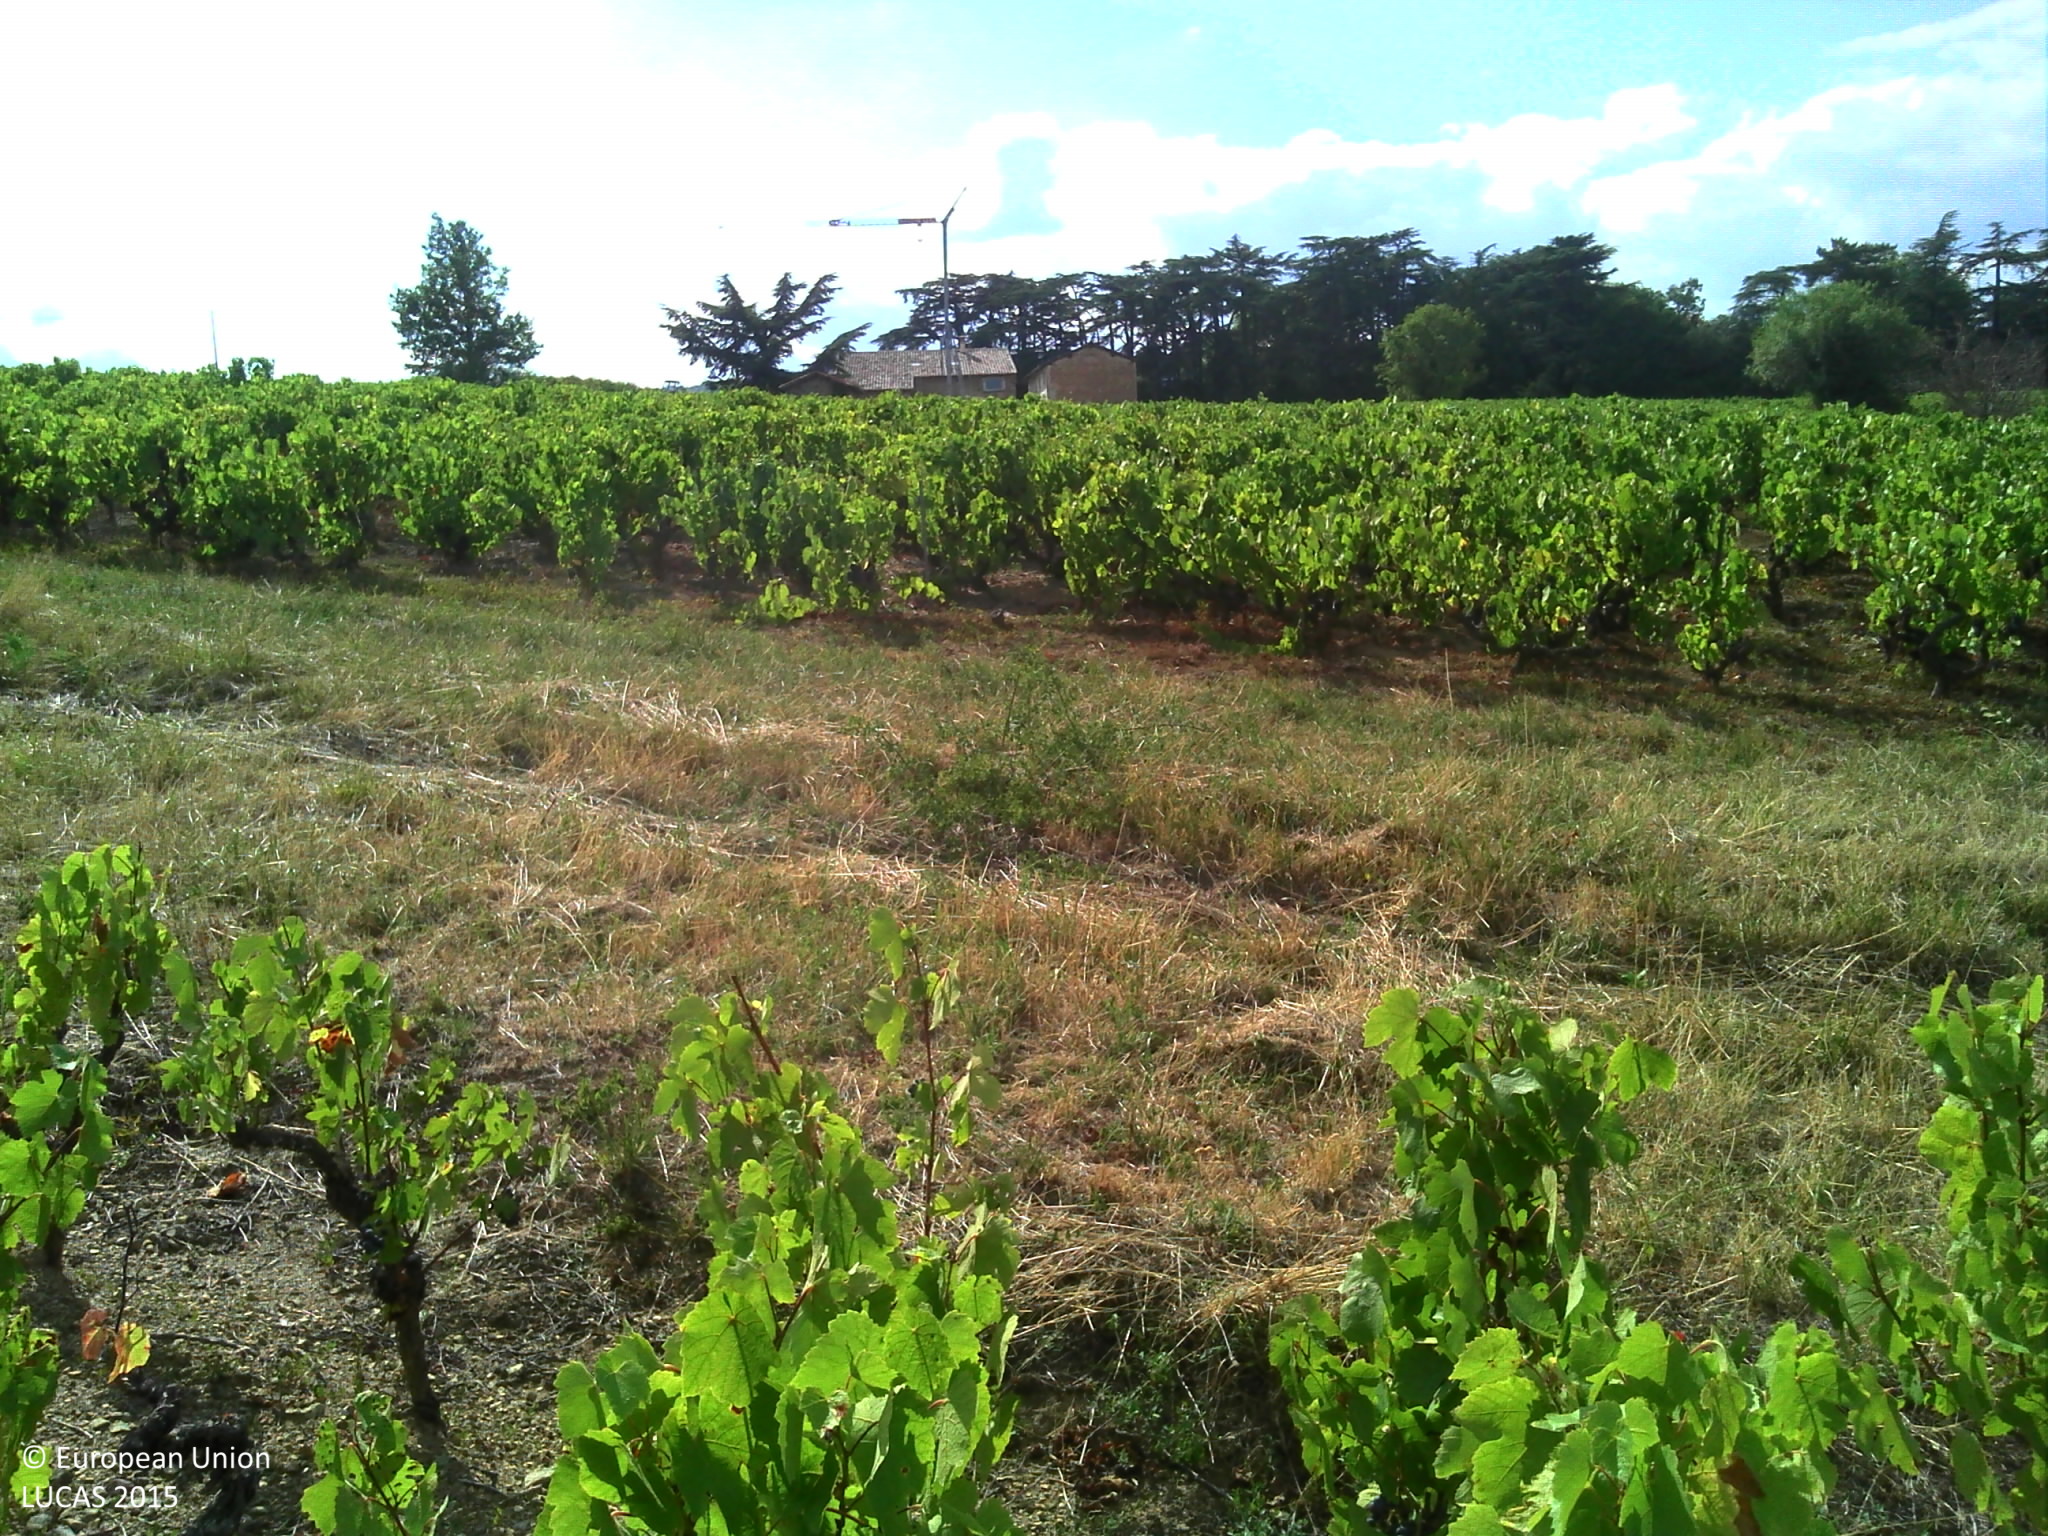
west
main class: Cropland
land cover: Vineyards
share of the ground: 50 - 75 %
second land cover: Other bare soil
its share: > 75 %
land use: Agriculture (excluding fallow land and kitchen gardens)
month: August
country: FR
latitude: 46.0915
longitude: 4.6609
